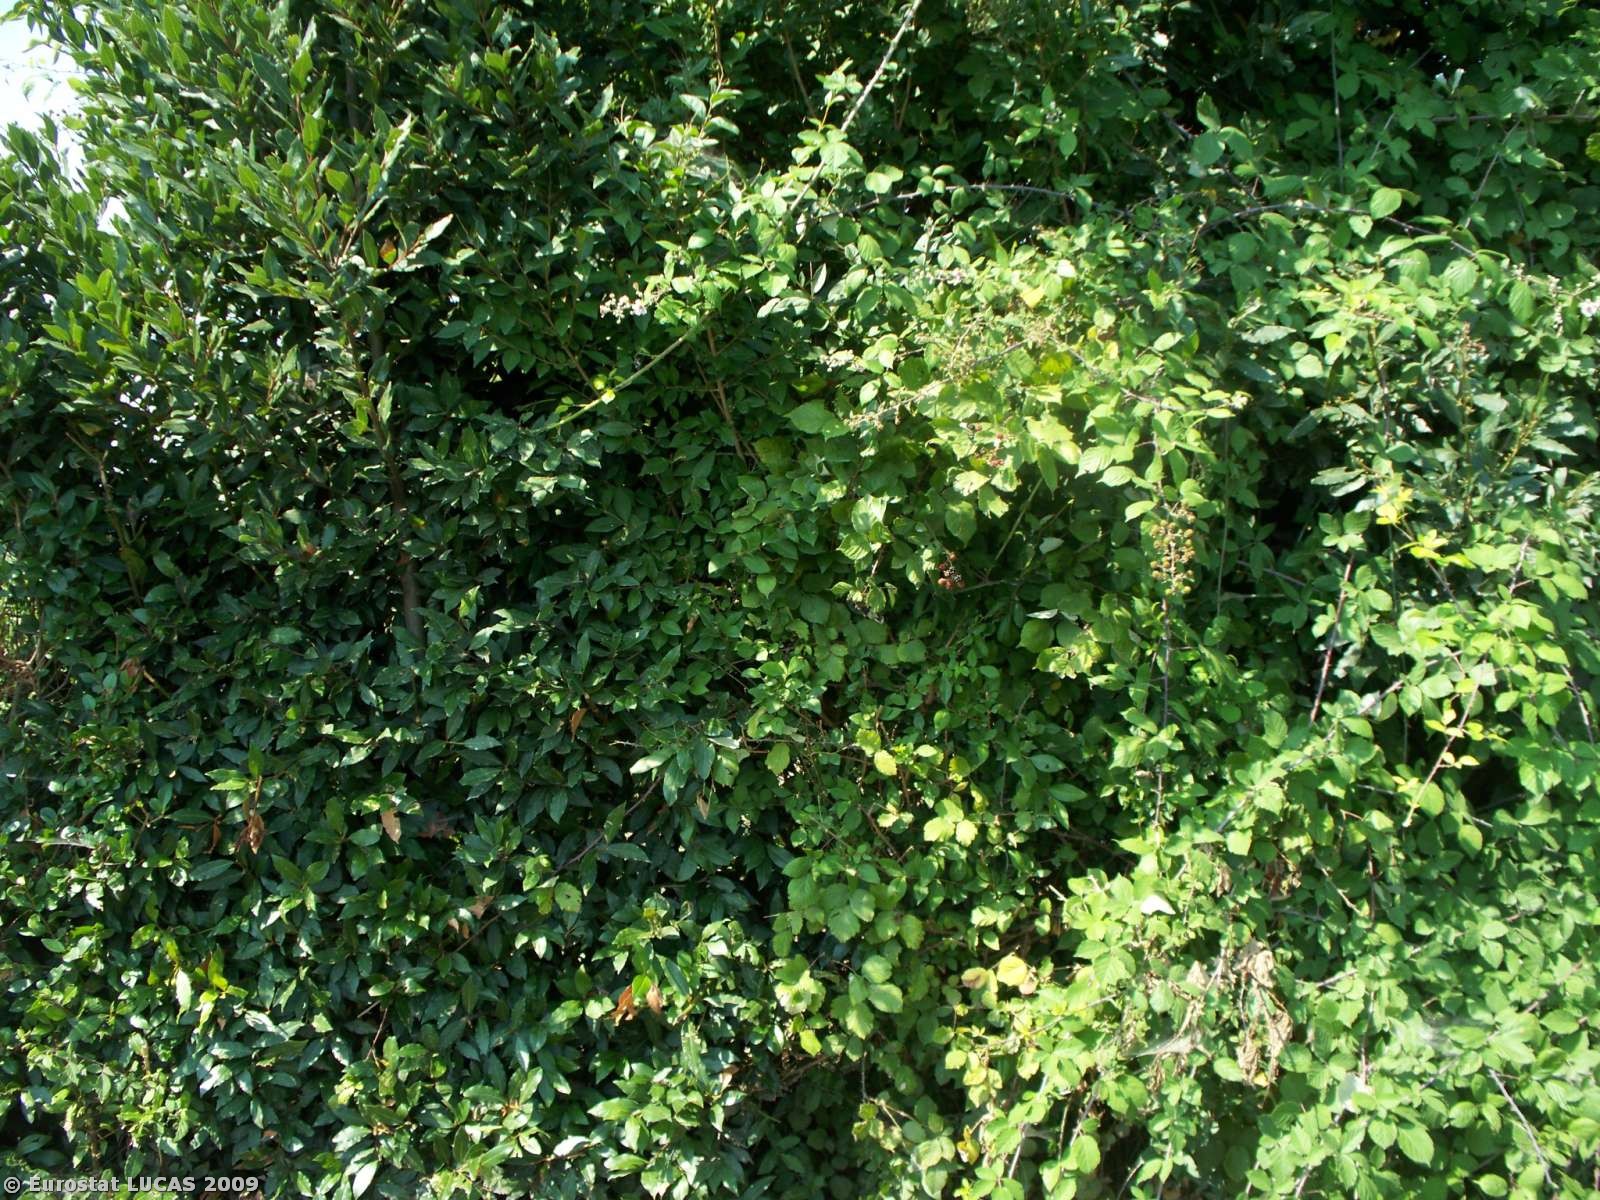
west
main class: Cropland
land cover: Soya
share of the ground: > 75 %
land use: Agriculture (excluding fallow land and kitchen gardens)
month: May
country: IT
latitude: 45.6613
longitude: 12.9607
